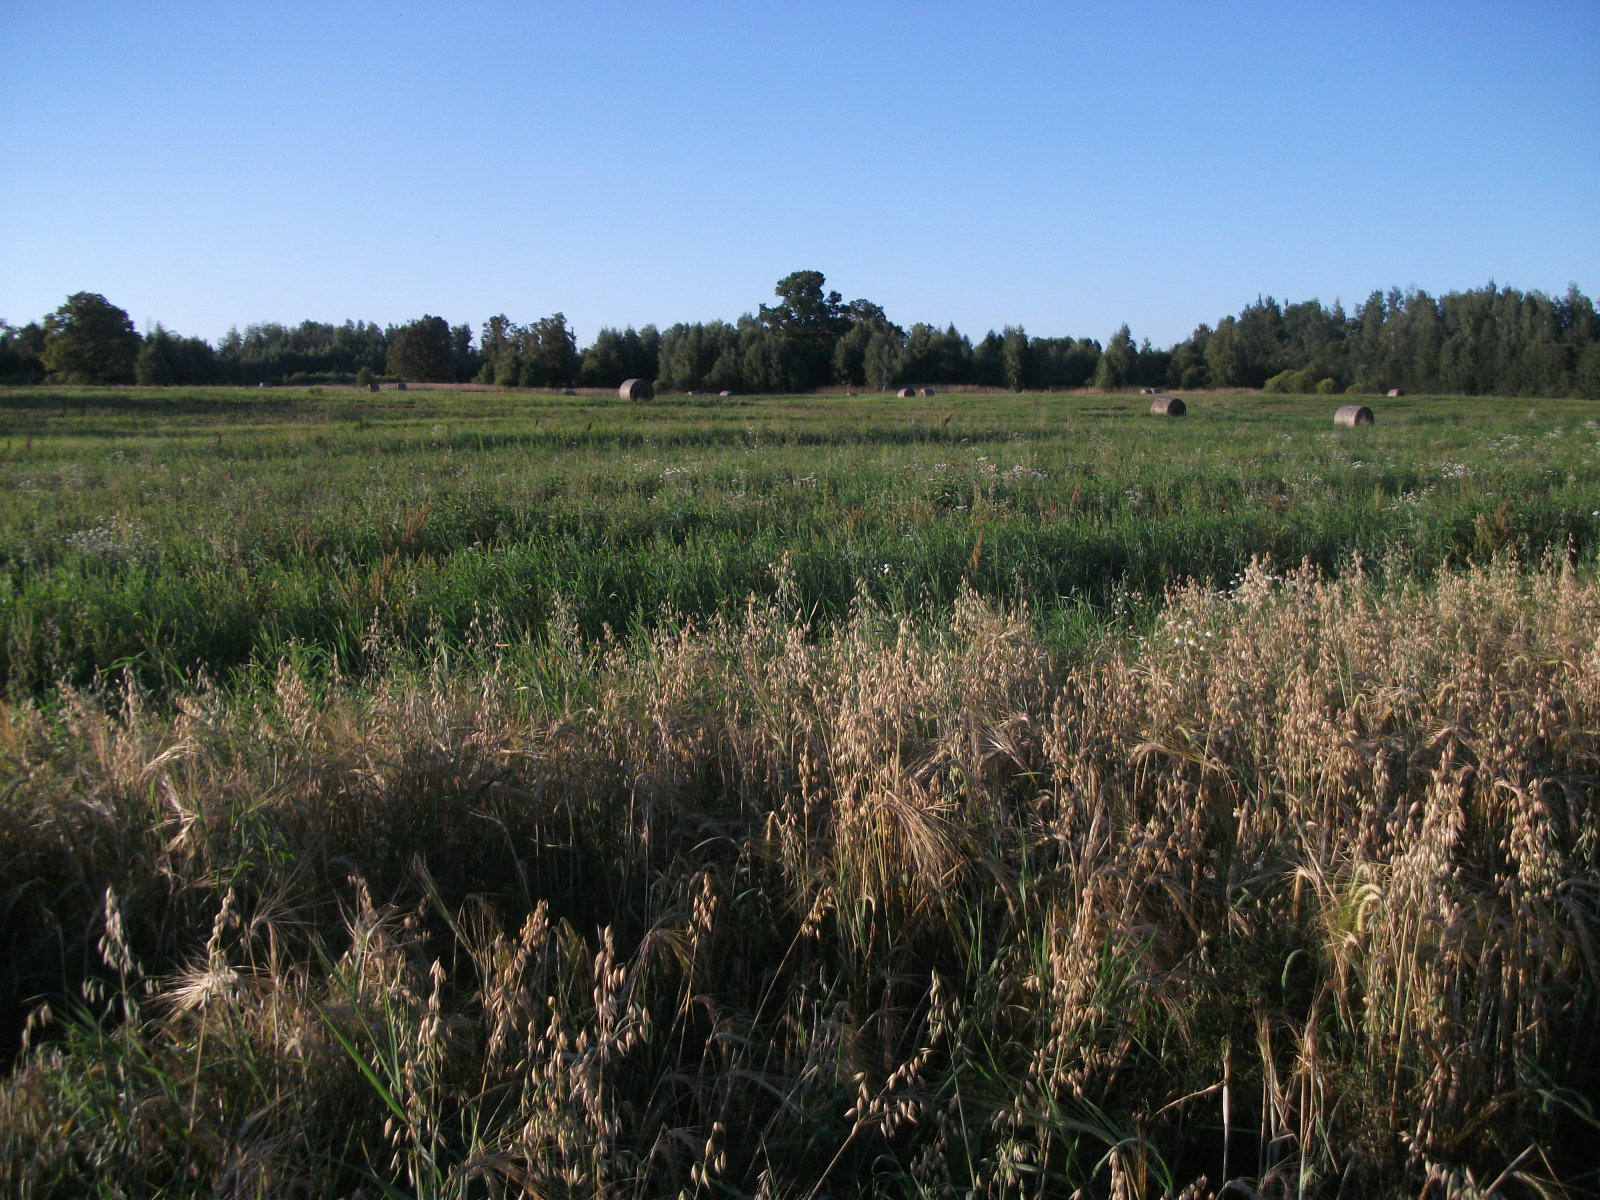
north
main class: Cropland
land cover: Mixed cereals for fodder
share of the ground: 50 - 75 %
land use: Agriculture (excluding fallow land and kitchen gardens)
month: August
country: LV
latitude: 56.3397
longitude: 26.3704
